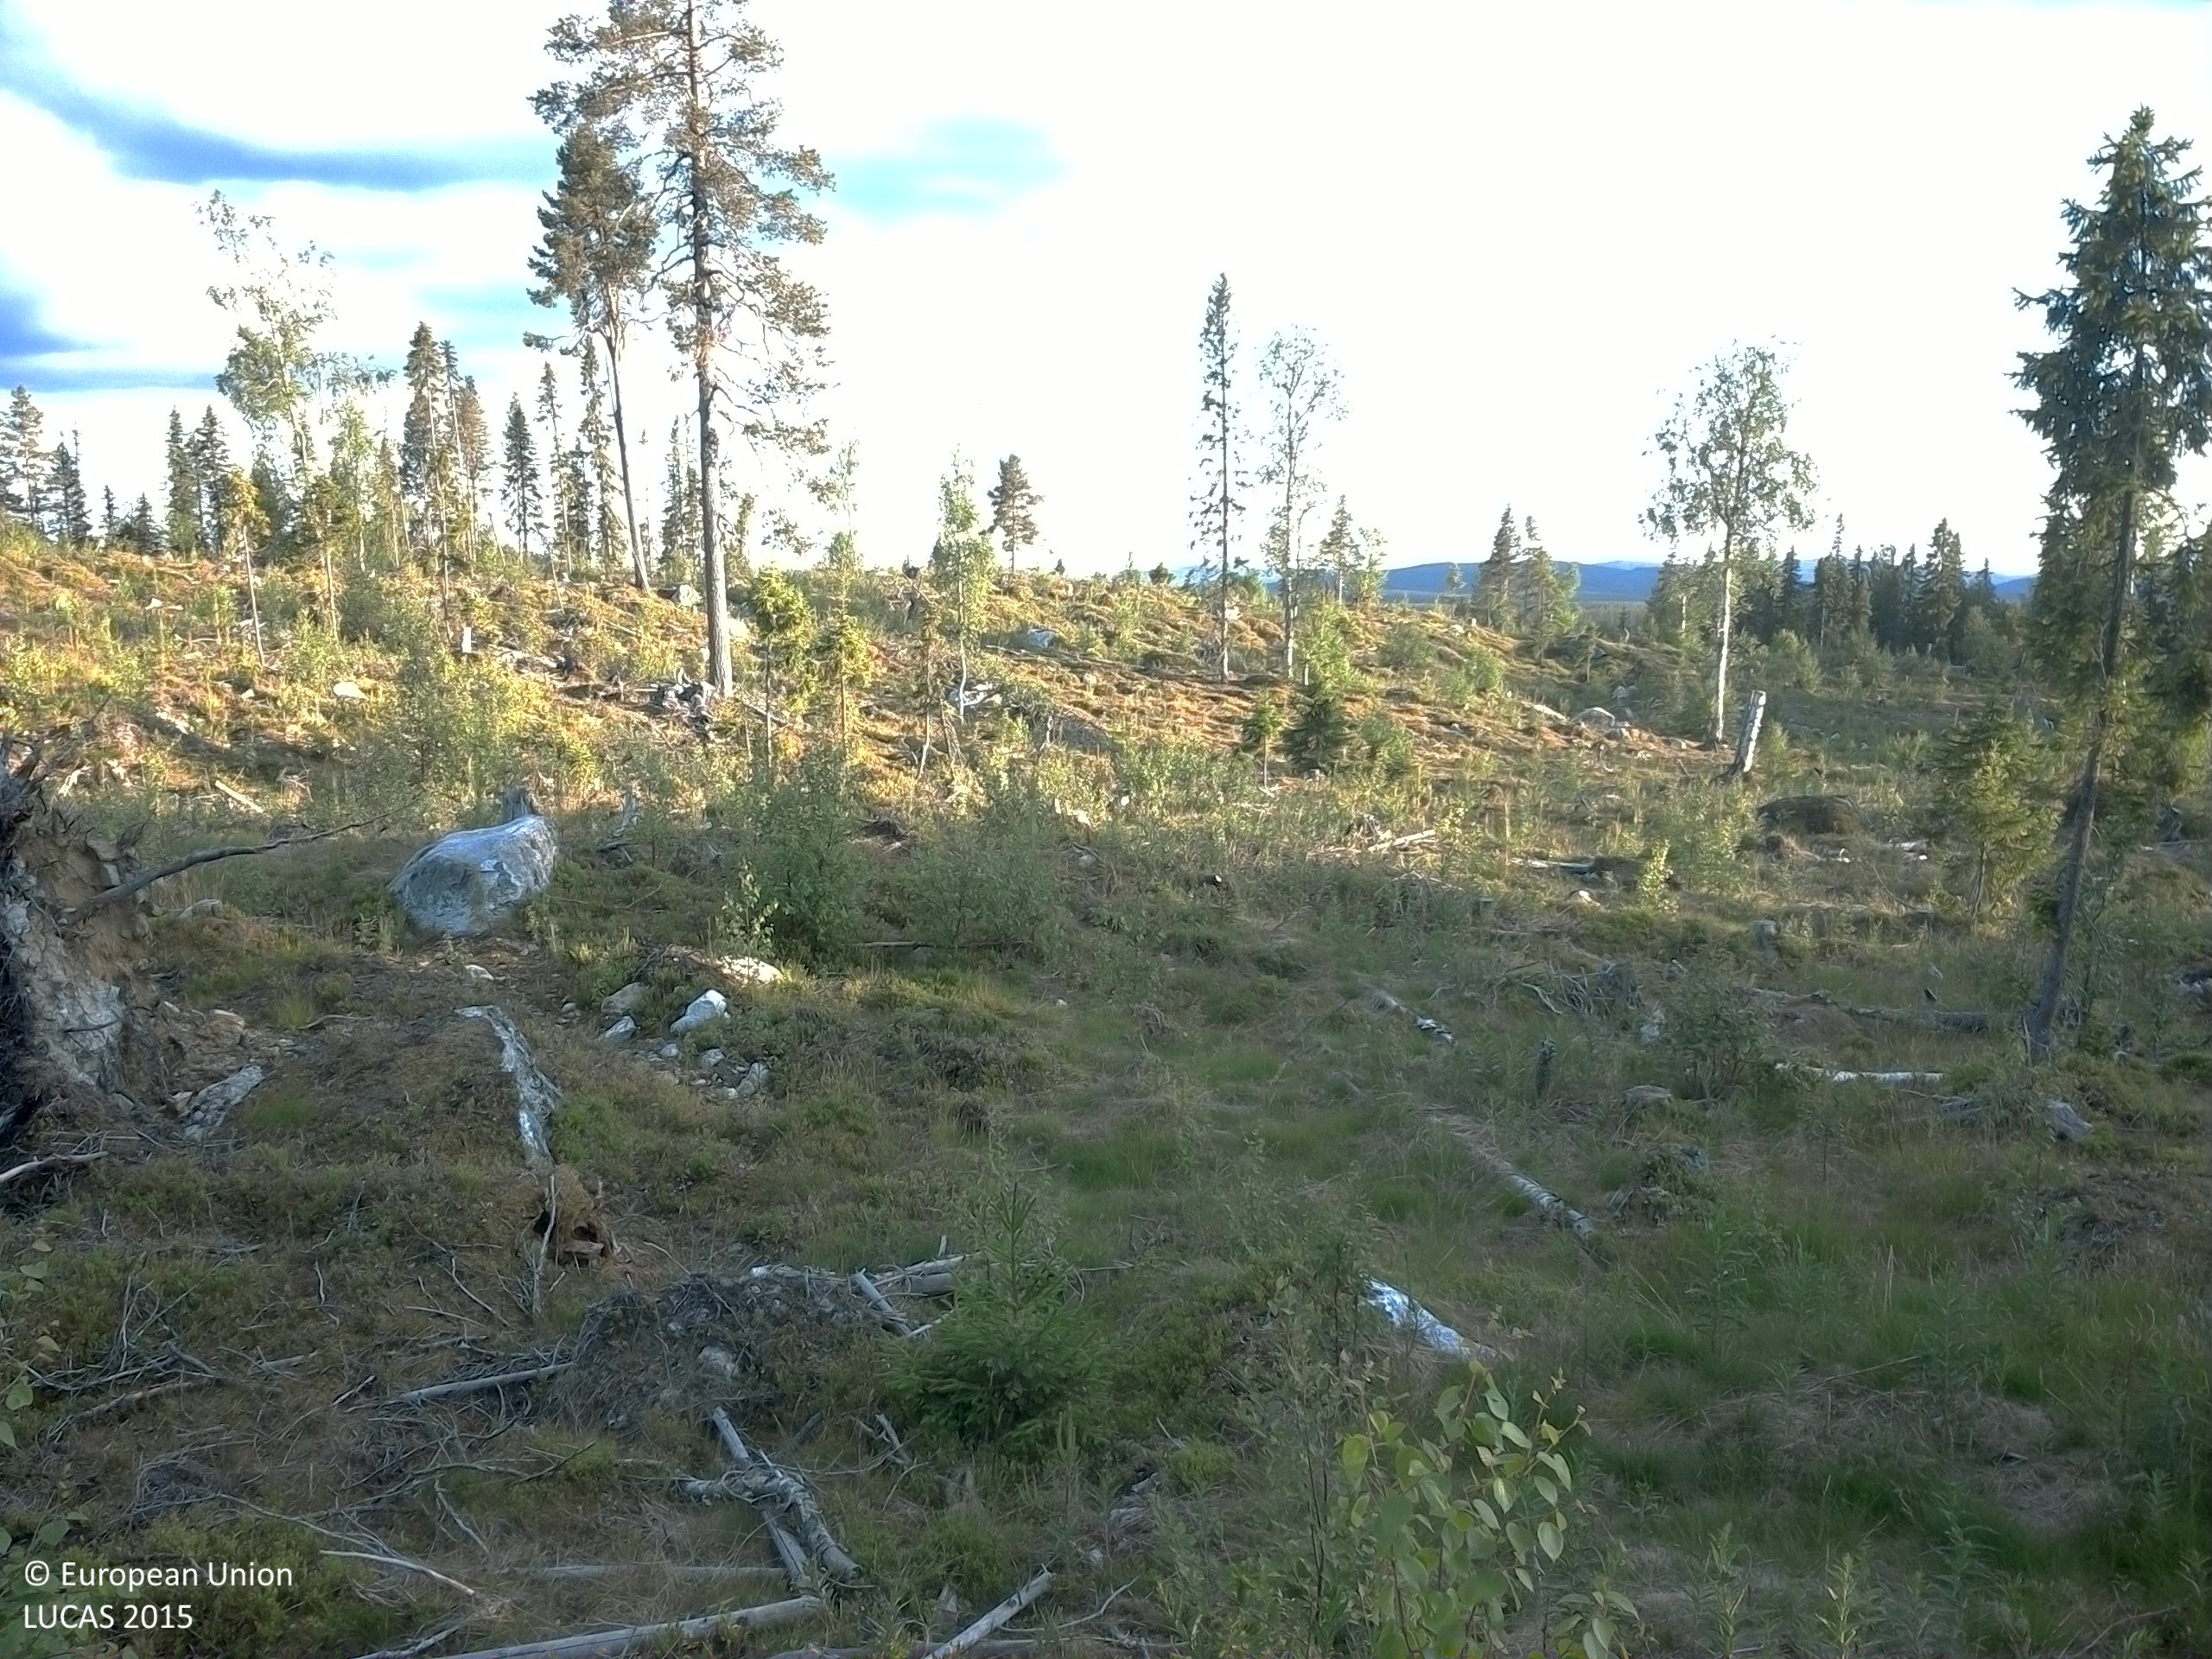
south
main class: Woodland
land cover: Pine dominated mixed woodland
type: boreal forest
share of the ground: 10 - 25 %
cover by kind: herbaceous plants 30 %, shrubs 20 %, lichens and mosses 15 %, consolidated bare surface 15 %, coniferous forest trees 10 %, broadleaved forest trees 5 %, unconsolidated bare surface 5 %
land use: Forestry
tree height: < 5 m
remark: Clear cut
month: July
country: SE
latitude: 64.3183
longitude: 16.5249
